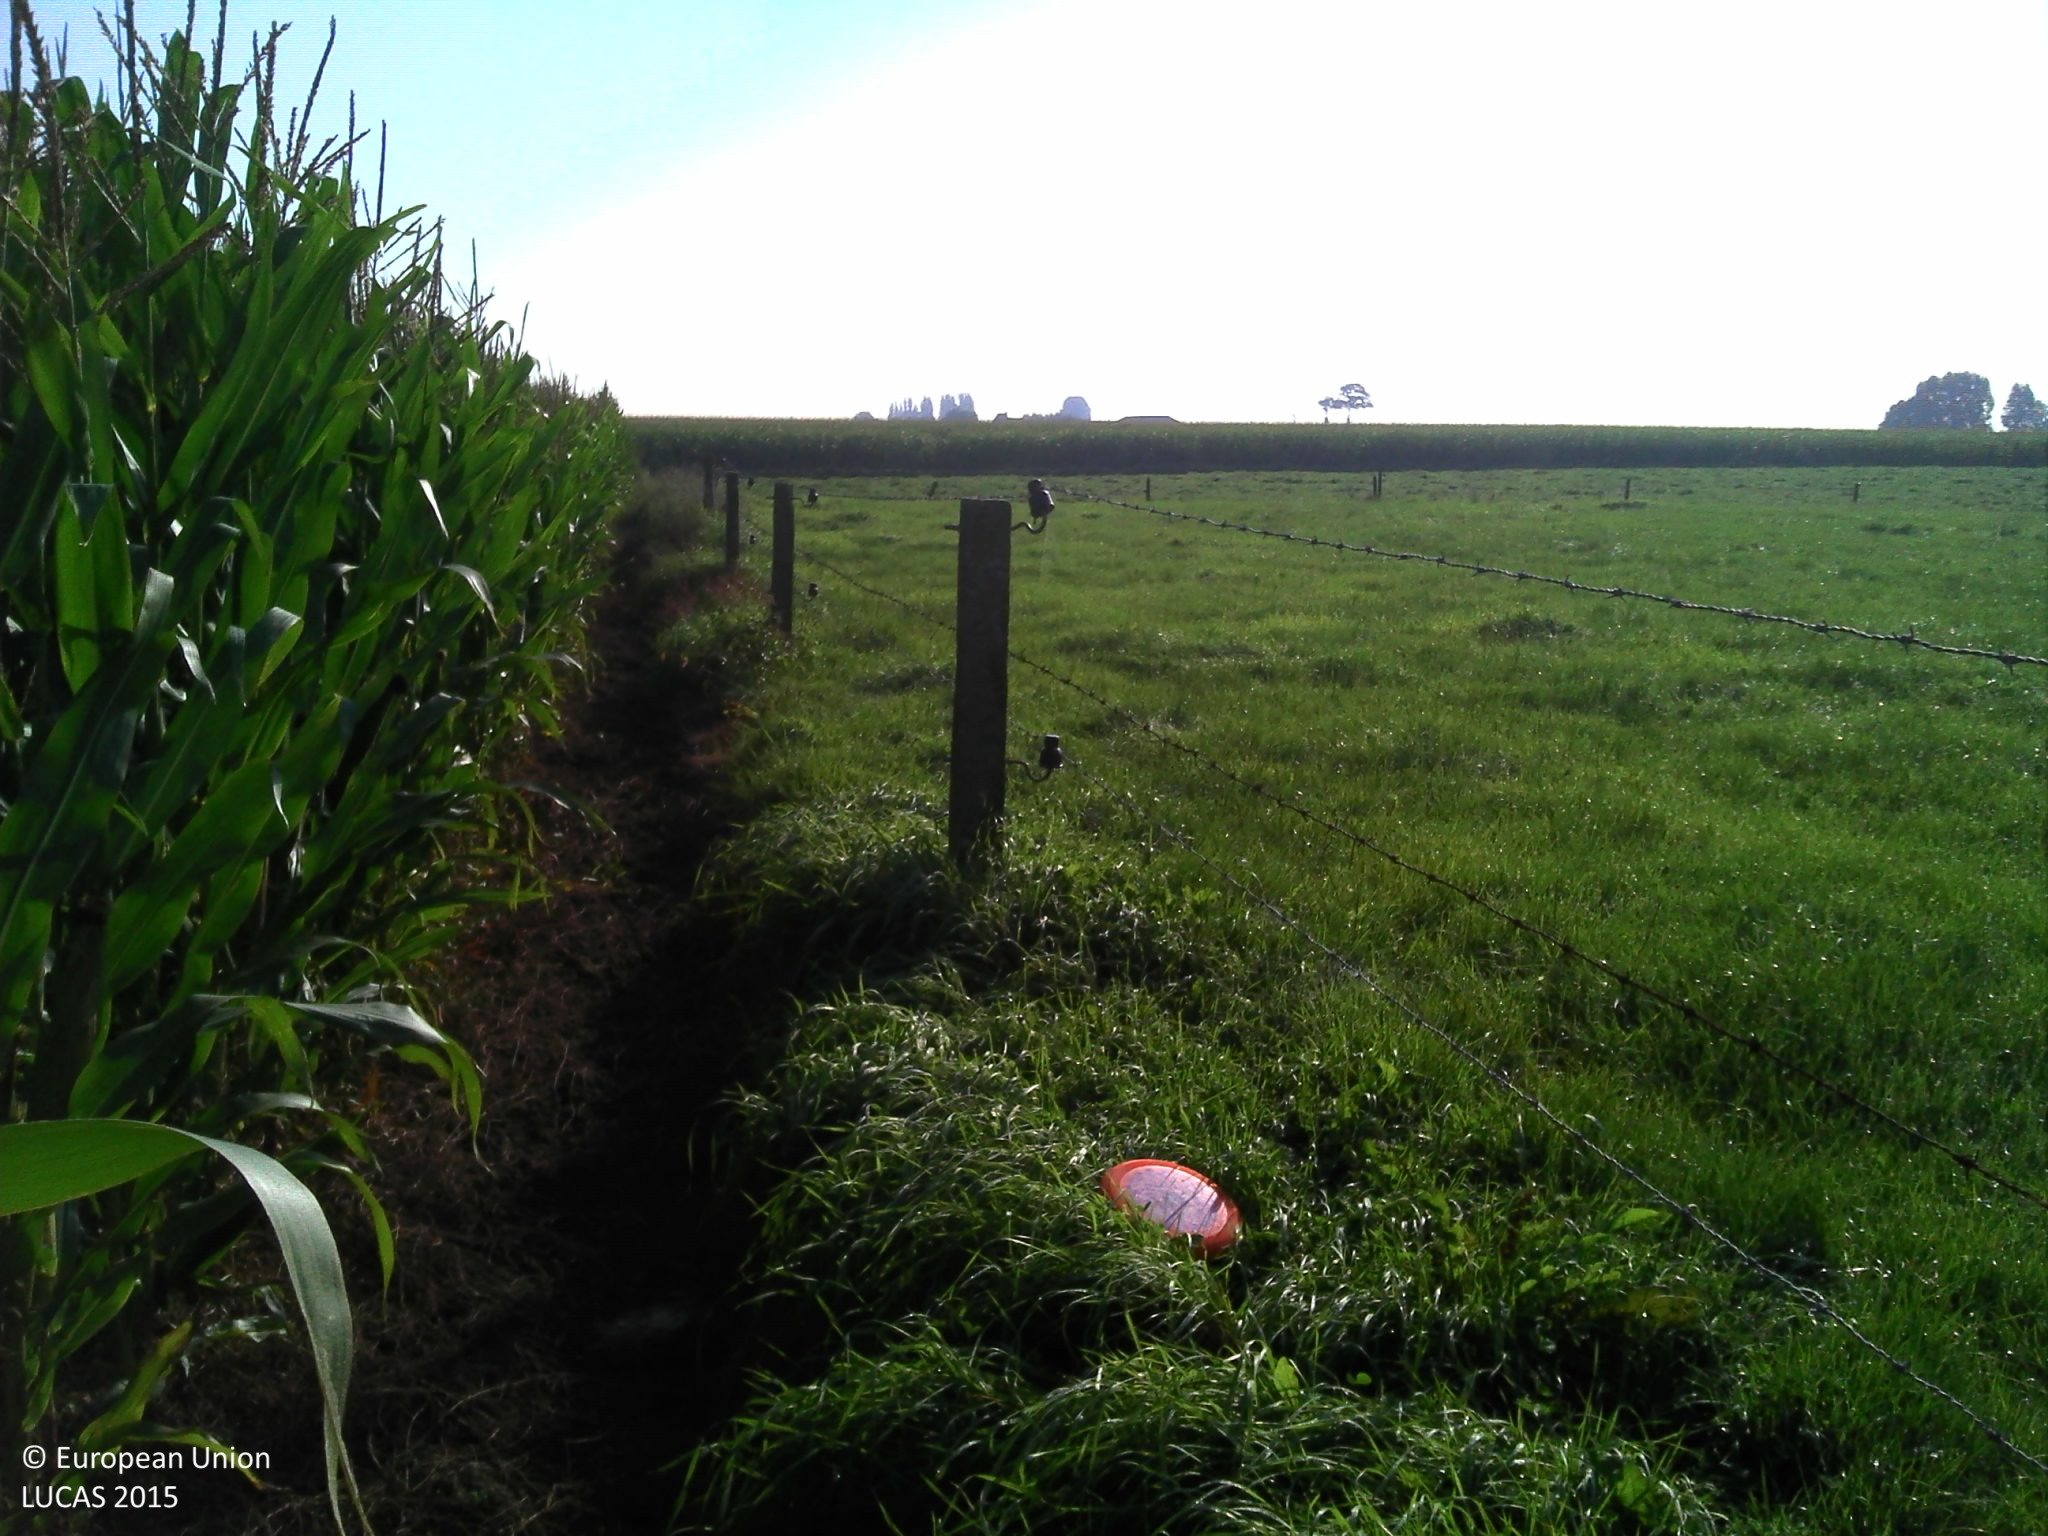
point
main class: Cropland
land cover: Maize
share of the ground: > 75 %
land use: Agriculture (excluding fallow land and kitchen gardens)
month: September
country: BE
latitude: 50.9977
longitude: 2.7071
